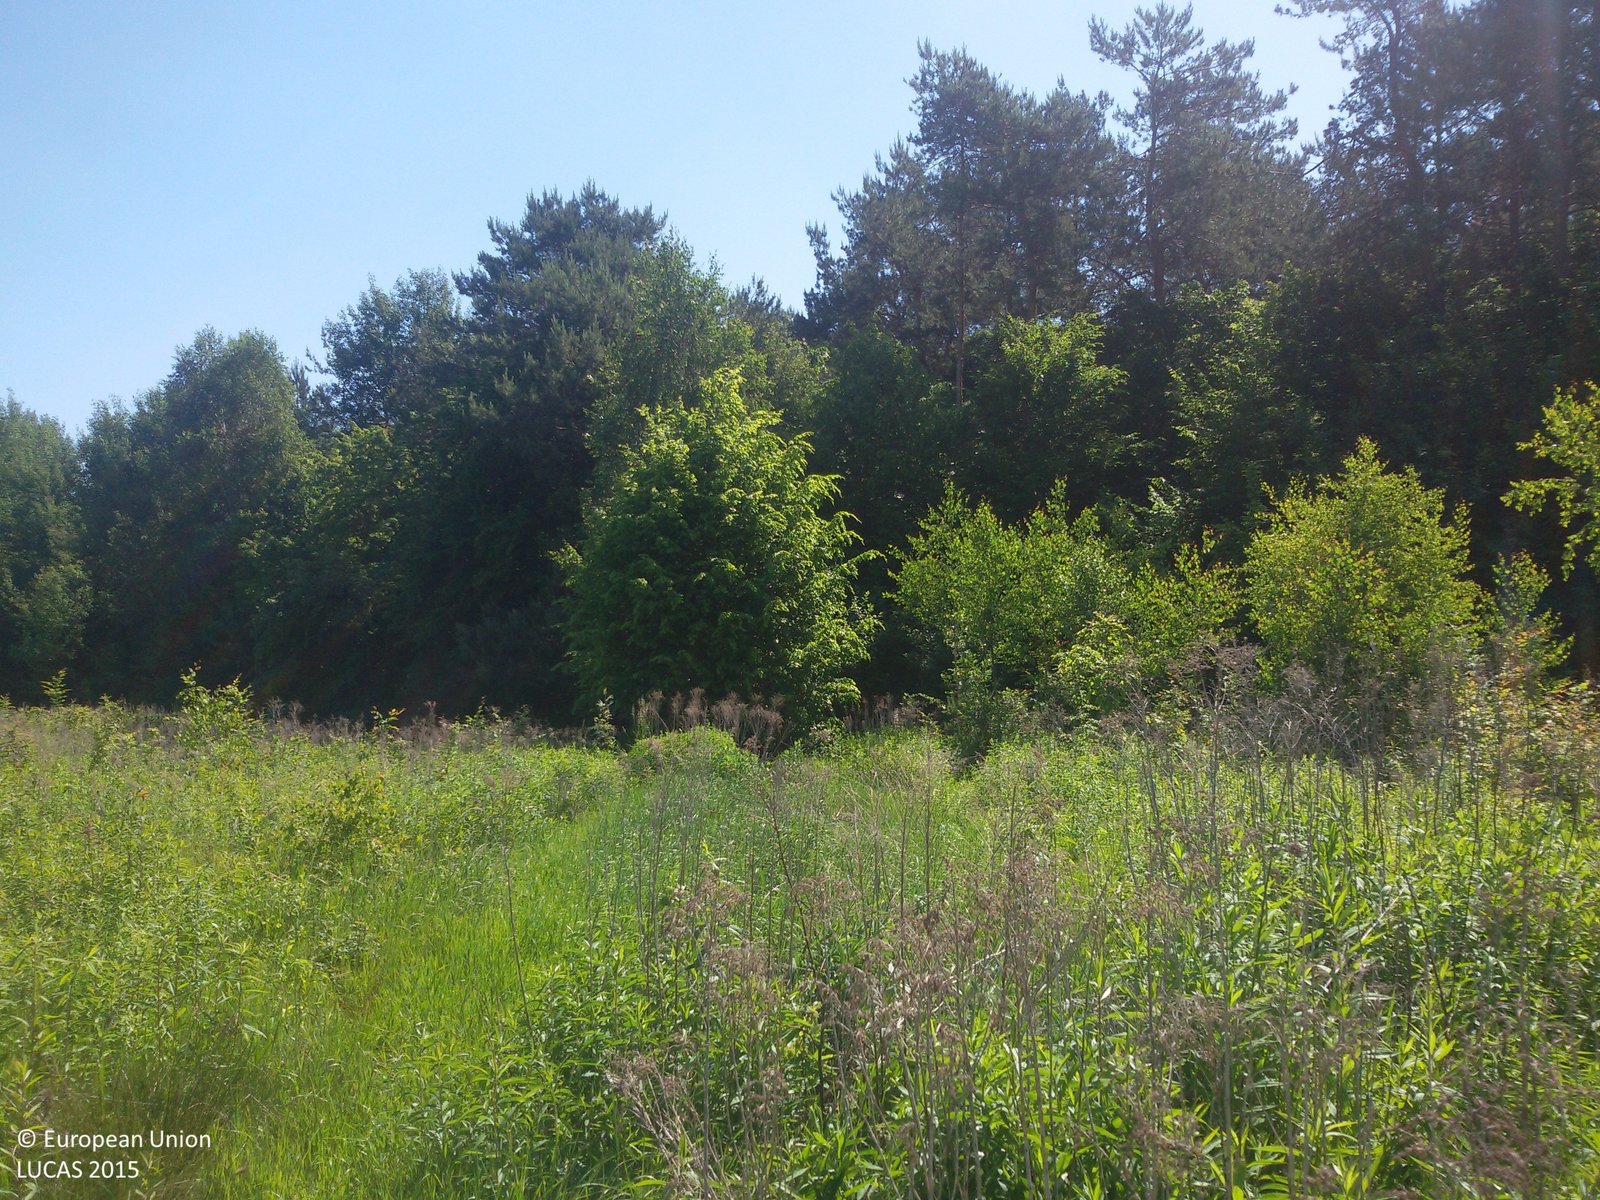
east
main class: Grassland
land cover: Grassland with sparse tree/shrub cover
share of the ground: > 75 %
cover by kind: herbaceous plants 90 %, broadleaved forest trees 5 %, shrubs 5 %
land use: Forestry
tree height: < 5 m
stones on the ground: < 10 %
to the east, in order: Grassland with sparse tree/shrub cover; Tracks; Pine dominated mixed woodland; Broadleaved woodland; Grassland with sparse tree/shrub cover
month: June
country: PL
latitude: 51.4114
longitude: 22.7664
